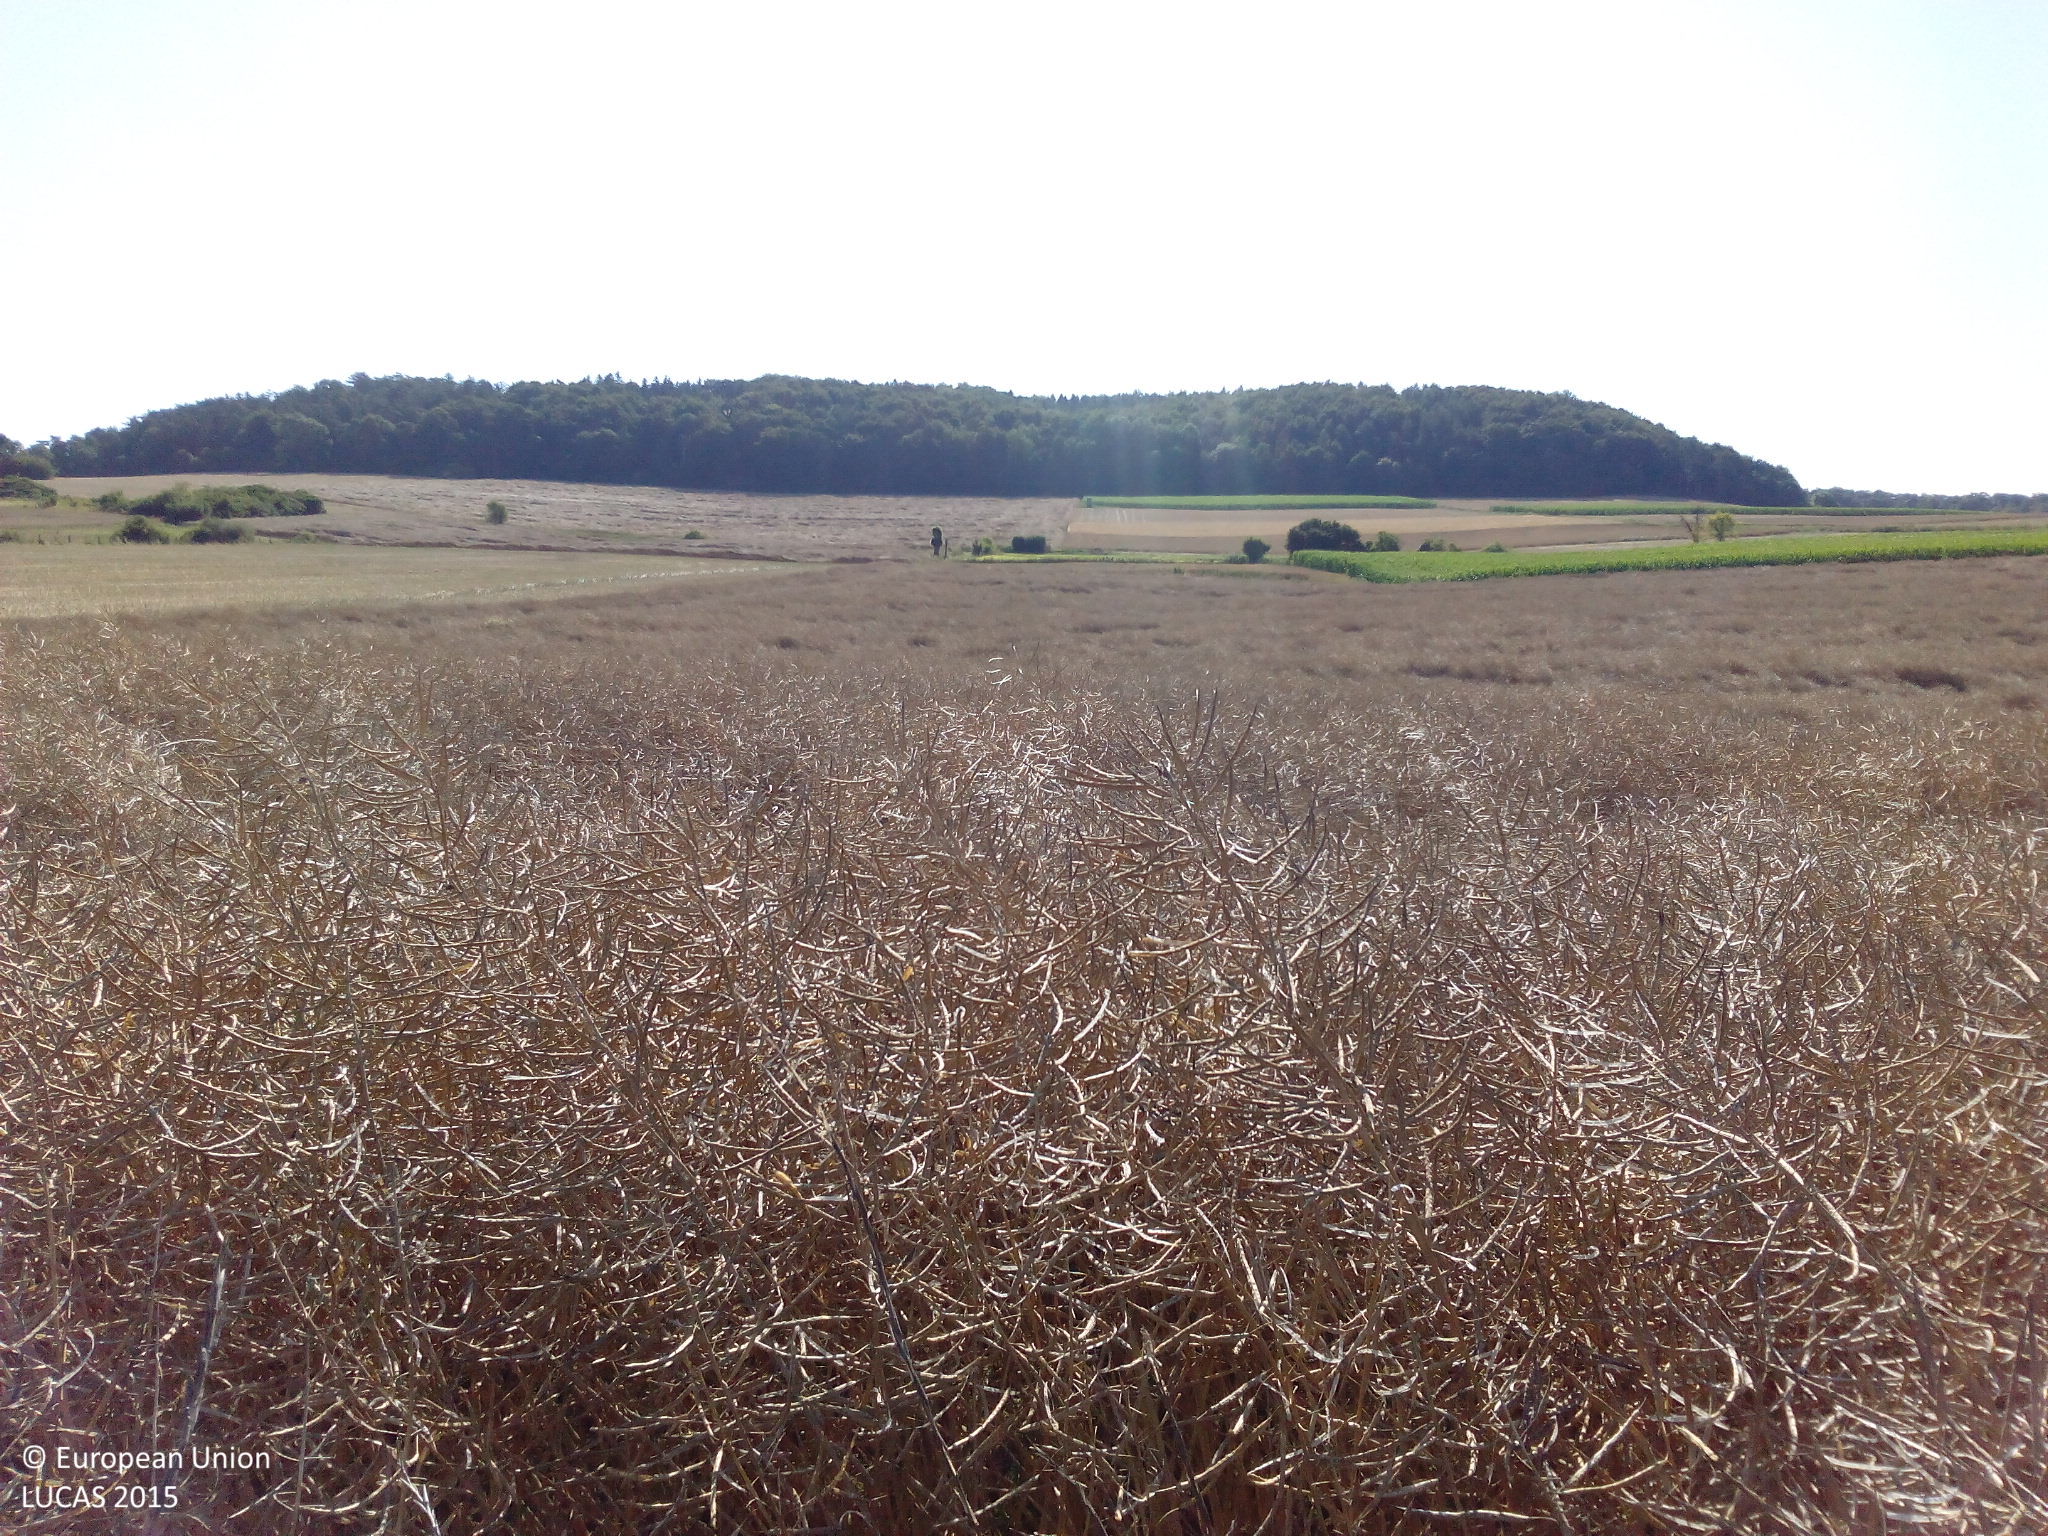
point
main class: Cropland
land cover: Rape and turnip rape
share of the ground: > 75 %
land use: Agriculture (excluding fallow land and kitchen gardens)
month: August
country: DE
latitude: 51.6919
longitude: 9.2335
